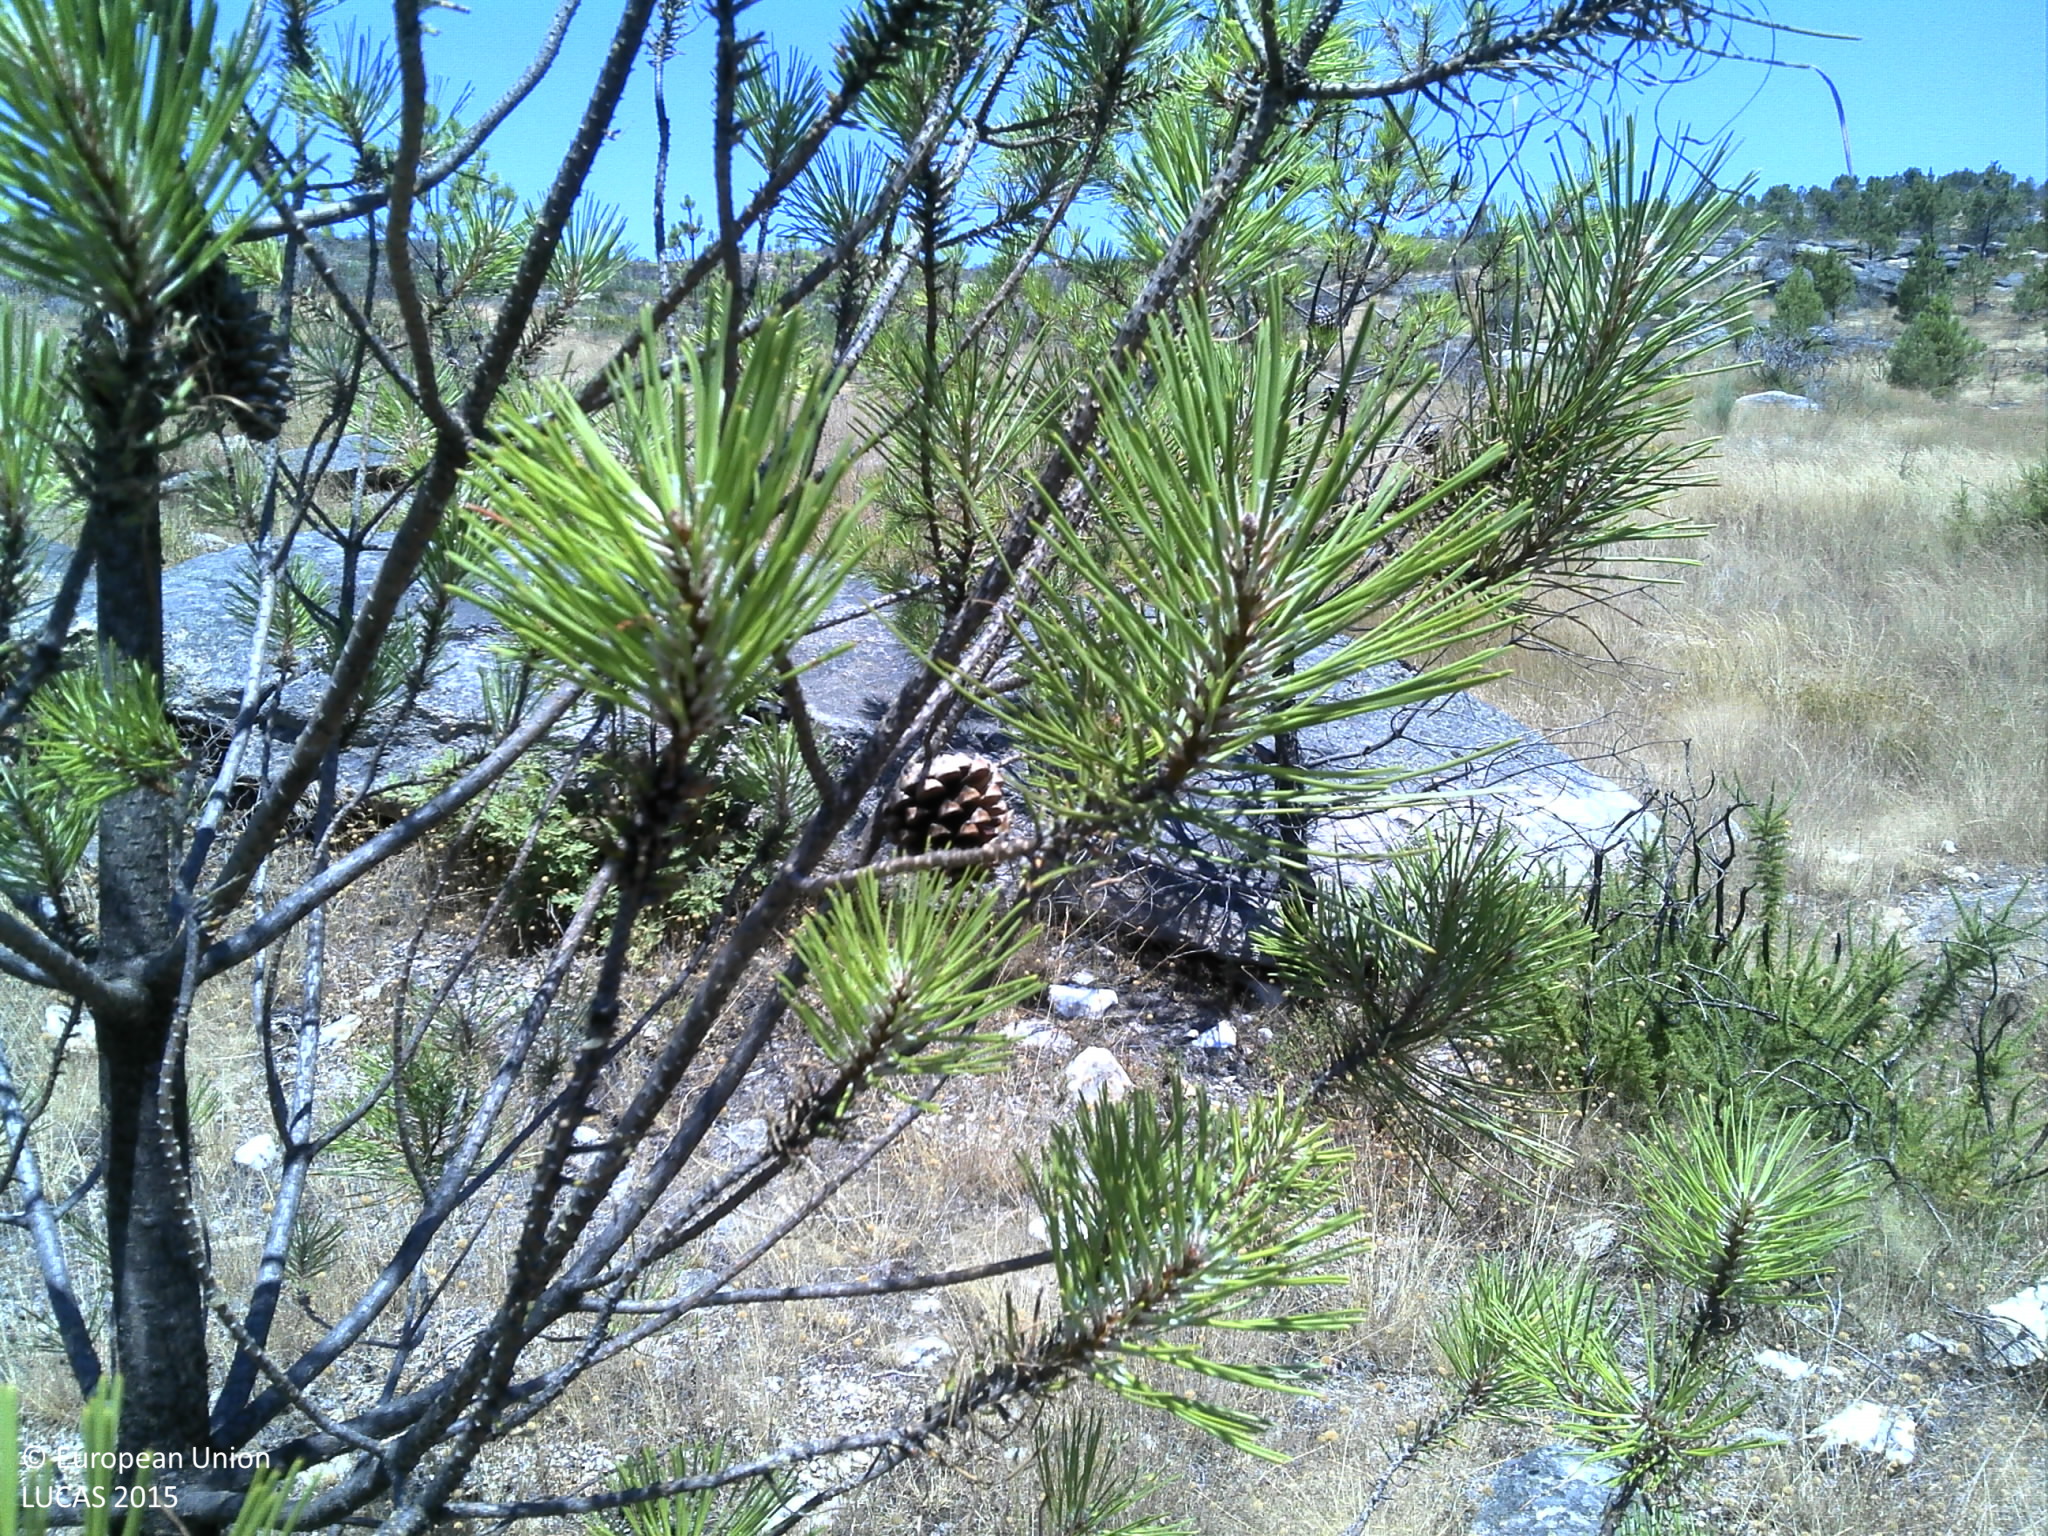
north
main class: Shrubland
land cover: Shrubland with sparse tree cover
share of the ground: 25 - 50 %
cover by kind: consolidated bare surface 30 %, shrubs 25 %, herbaceous plants 20 %, unconsolidated bare surface 20 %, coniferous forest trees 5 %
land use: Forestry
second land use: Agriculture (excluding fallow land and kitchen gardens)
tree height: < 5 m
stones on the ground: 10 - 25 %
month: July
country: PT
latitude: 41.7129
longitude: -7.6707
